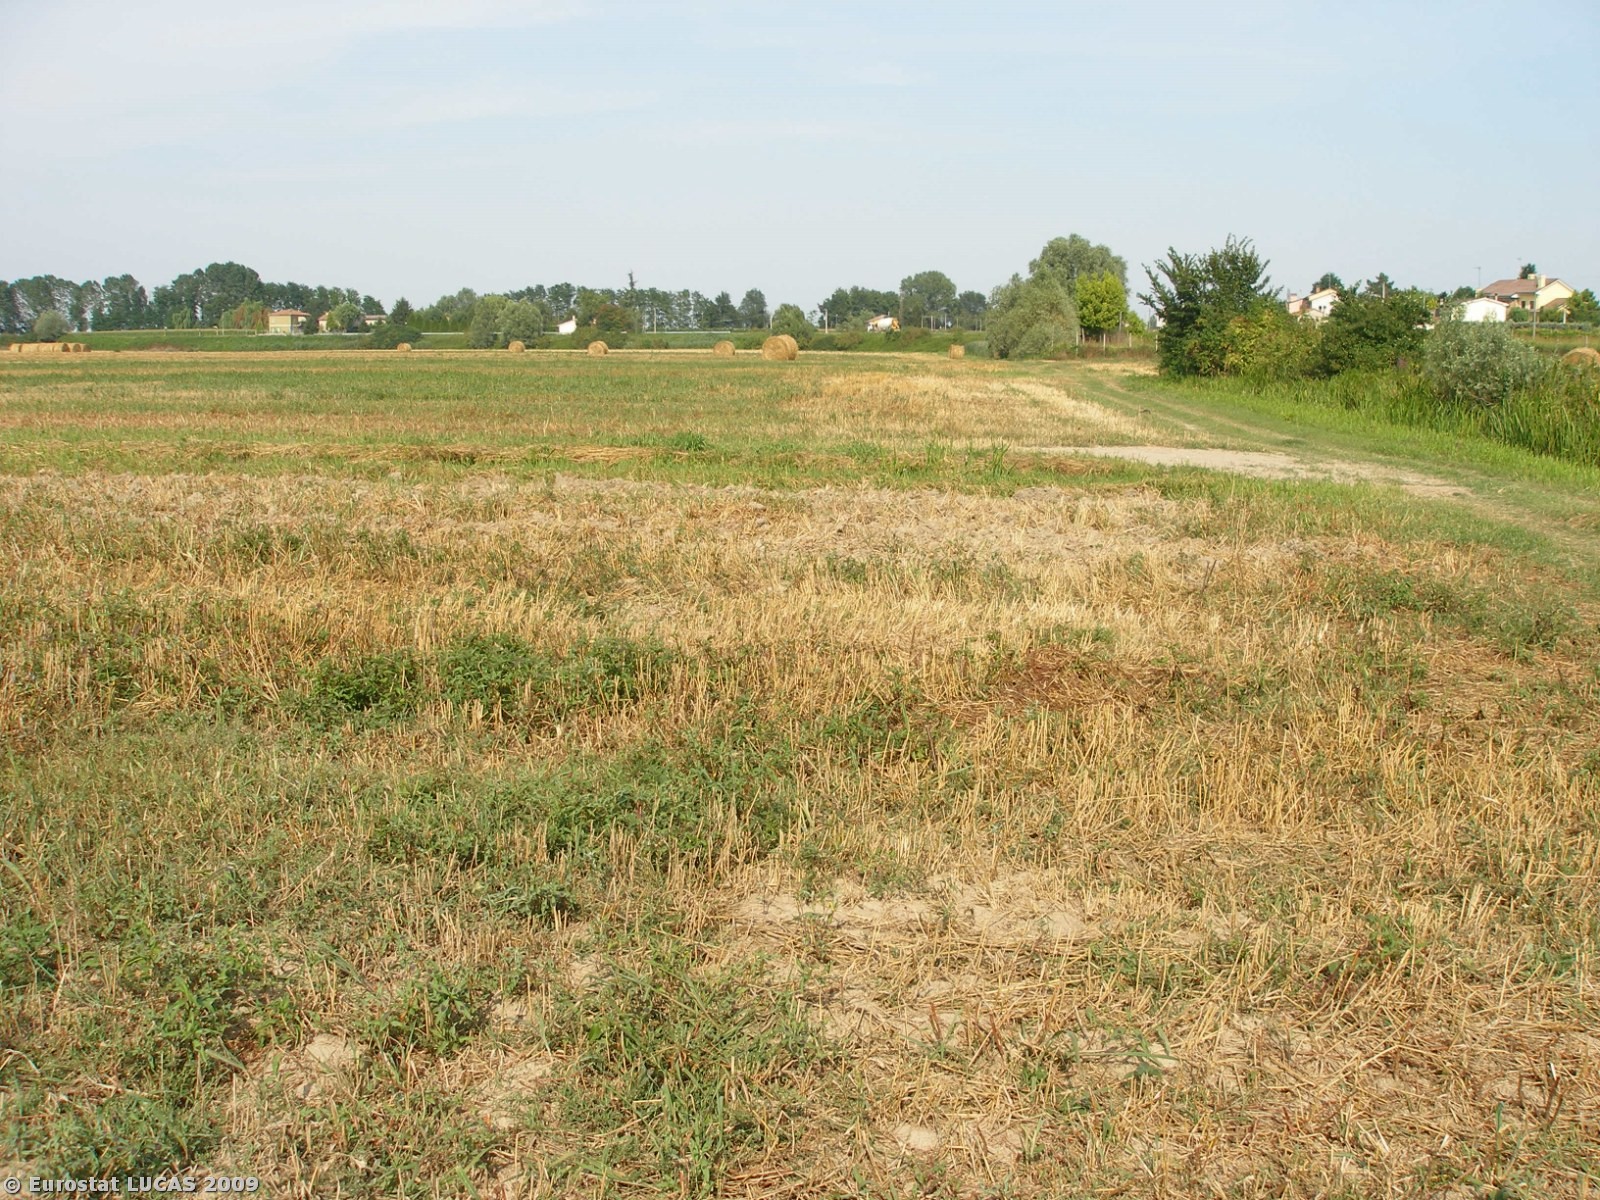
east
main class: Cropland
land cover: Tomatoes
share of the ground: > 75 %
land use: Agriculture (excluding fallow land and kitchen gardens)
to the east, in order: Tomatoes; Ditches and canals; Tomatoes; Ditches and canals; Tomatoes; Tracks; Common wheat; Ditches and canals; Common wheat; Tracks; Common wheat; Ditches and canals; Common wheat
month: July
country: IT
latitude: 45.0050
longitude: 11.6335
